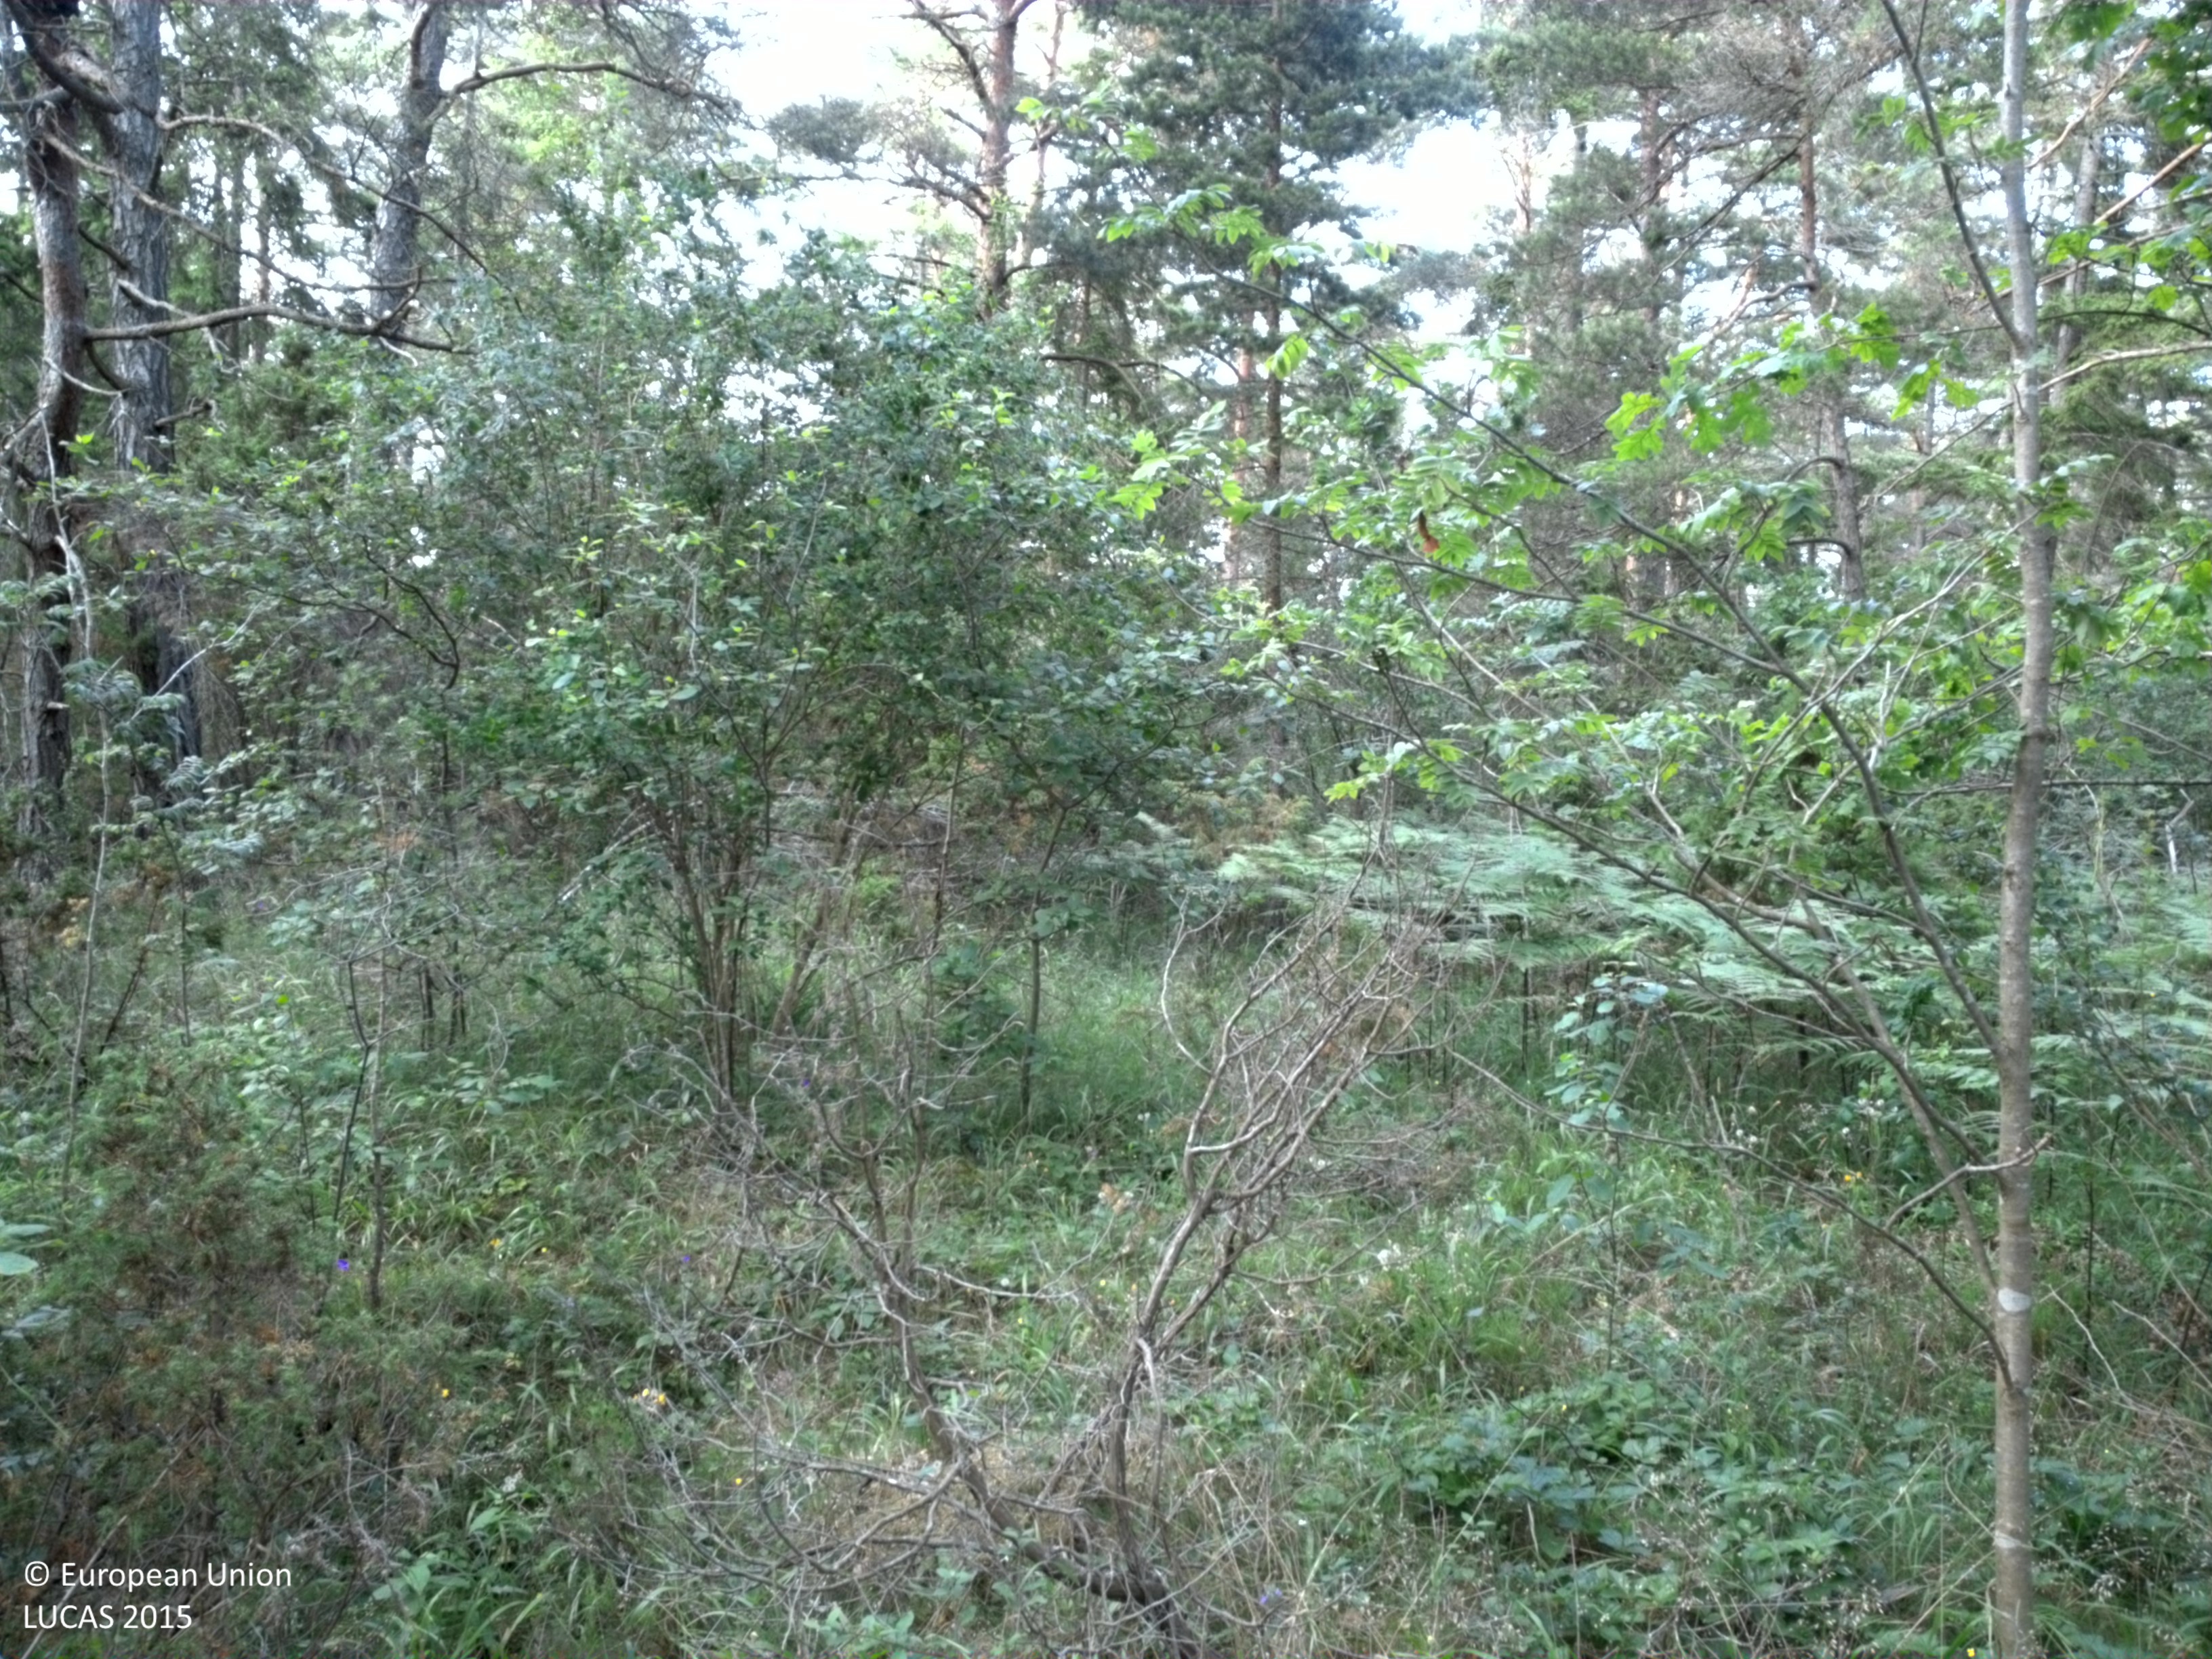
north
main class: Woodland
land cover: Pine dominated coniferous woodland
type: hemiboreal forest and nemoral coniferous forest and mixed broadleaved-coniferous forest
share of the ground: > 75 %
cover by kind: coniferous forest trees 75 %, shrubs 10 %, herbaceous plants 10 %, lichens and mosses 5 %
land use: Forestry
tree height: > 5 m
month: July
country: SE
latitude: 57.5657
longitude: 18.2821
